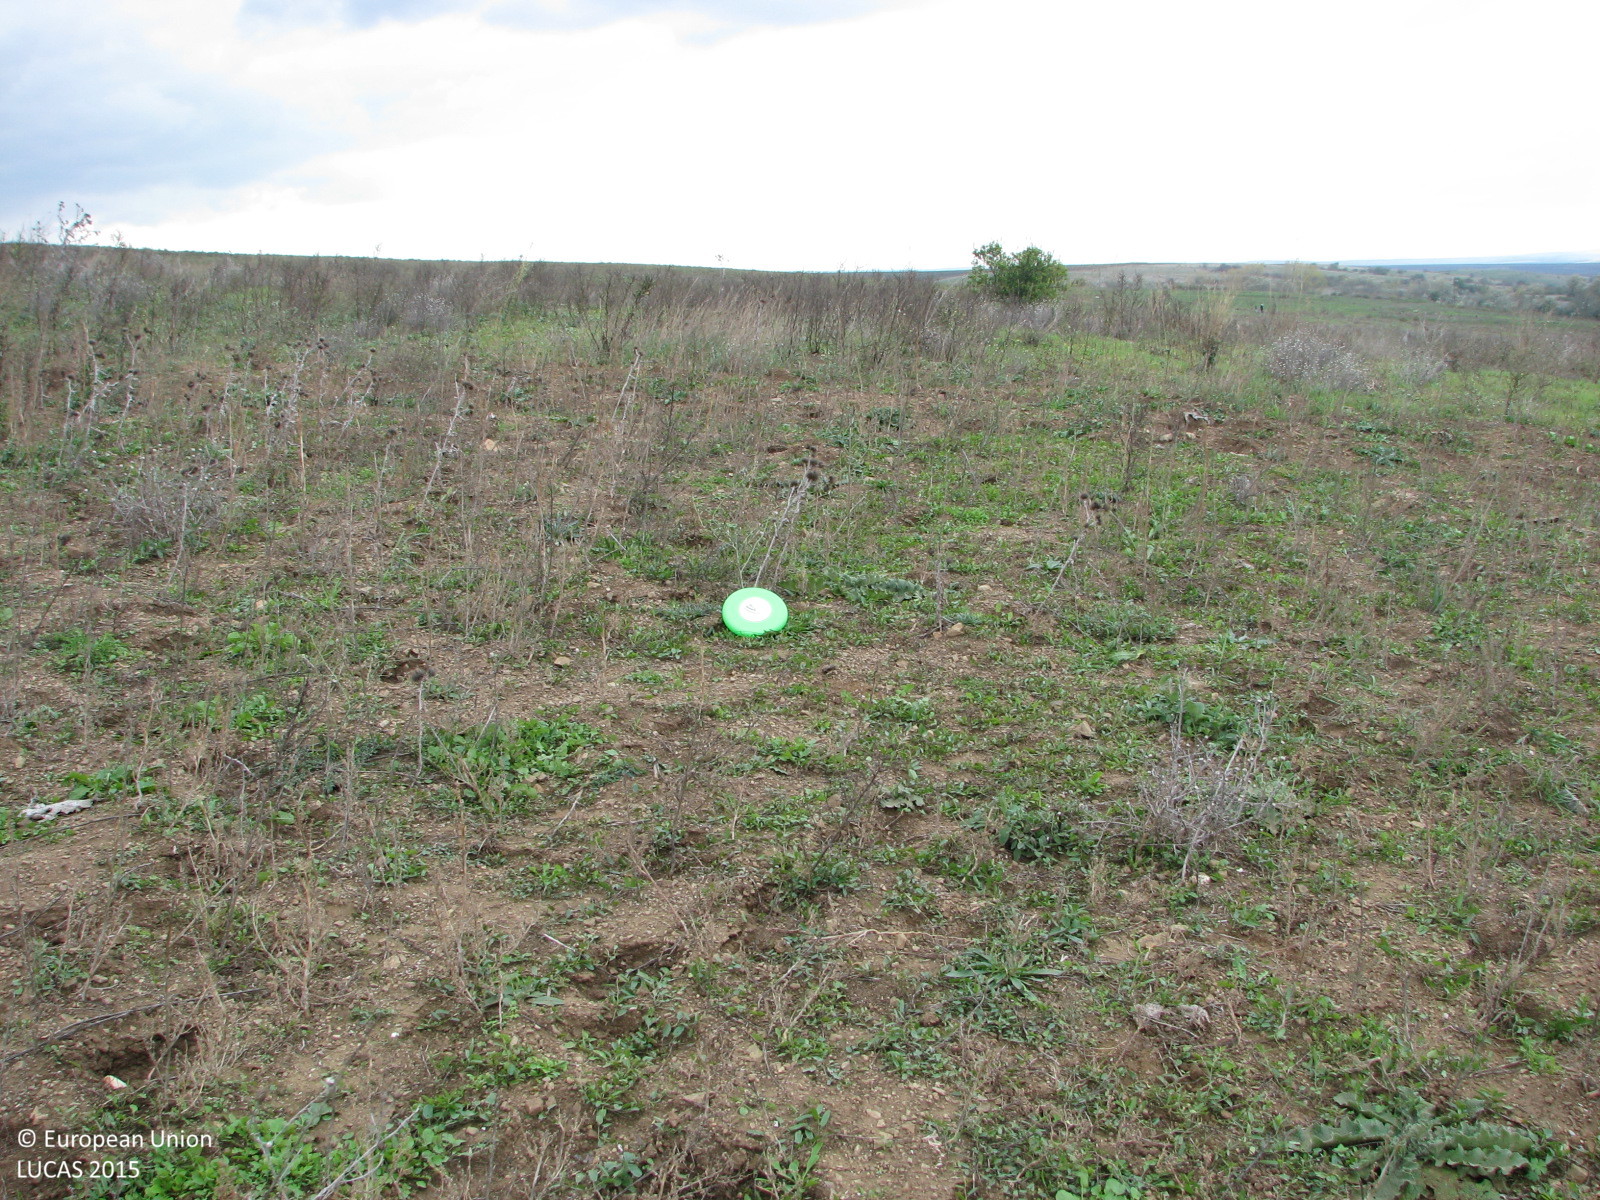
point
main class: Grassland
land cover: Spontaneously vegetated surfaces
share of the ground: 50 - 75 %
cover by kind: herbaceous plants 60 %, unconsolidated bare surface 40 %
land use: Fallow land
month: October
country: BG
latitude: 42.2089
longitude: 26.7243
